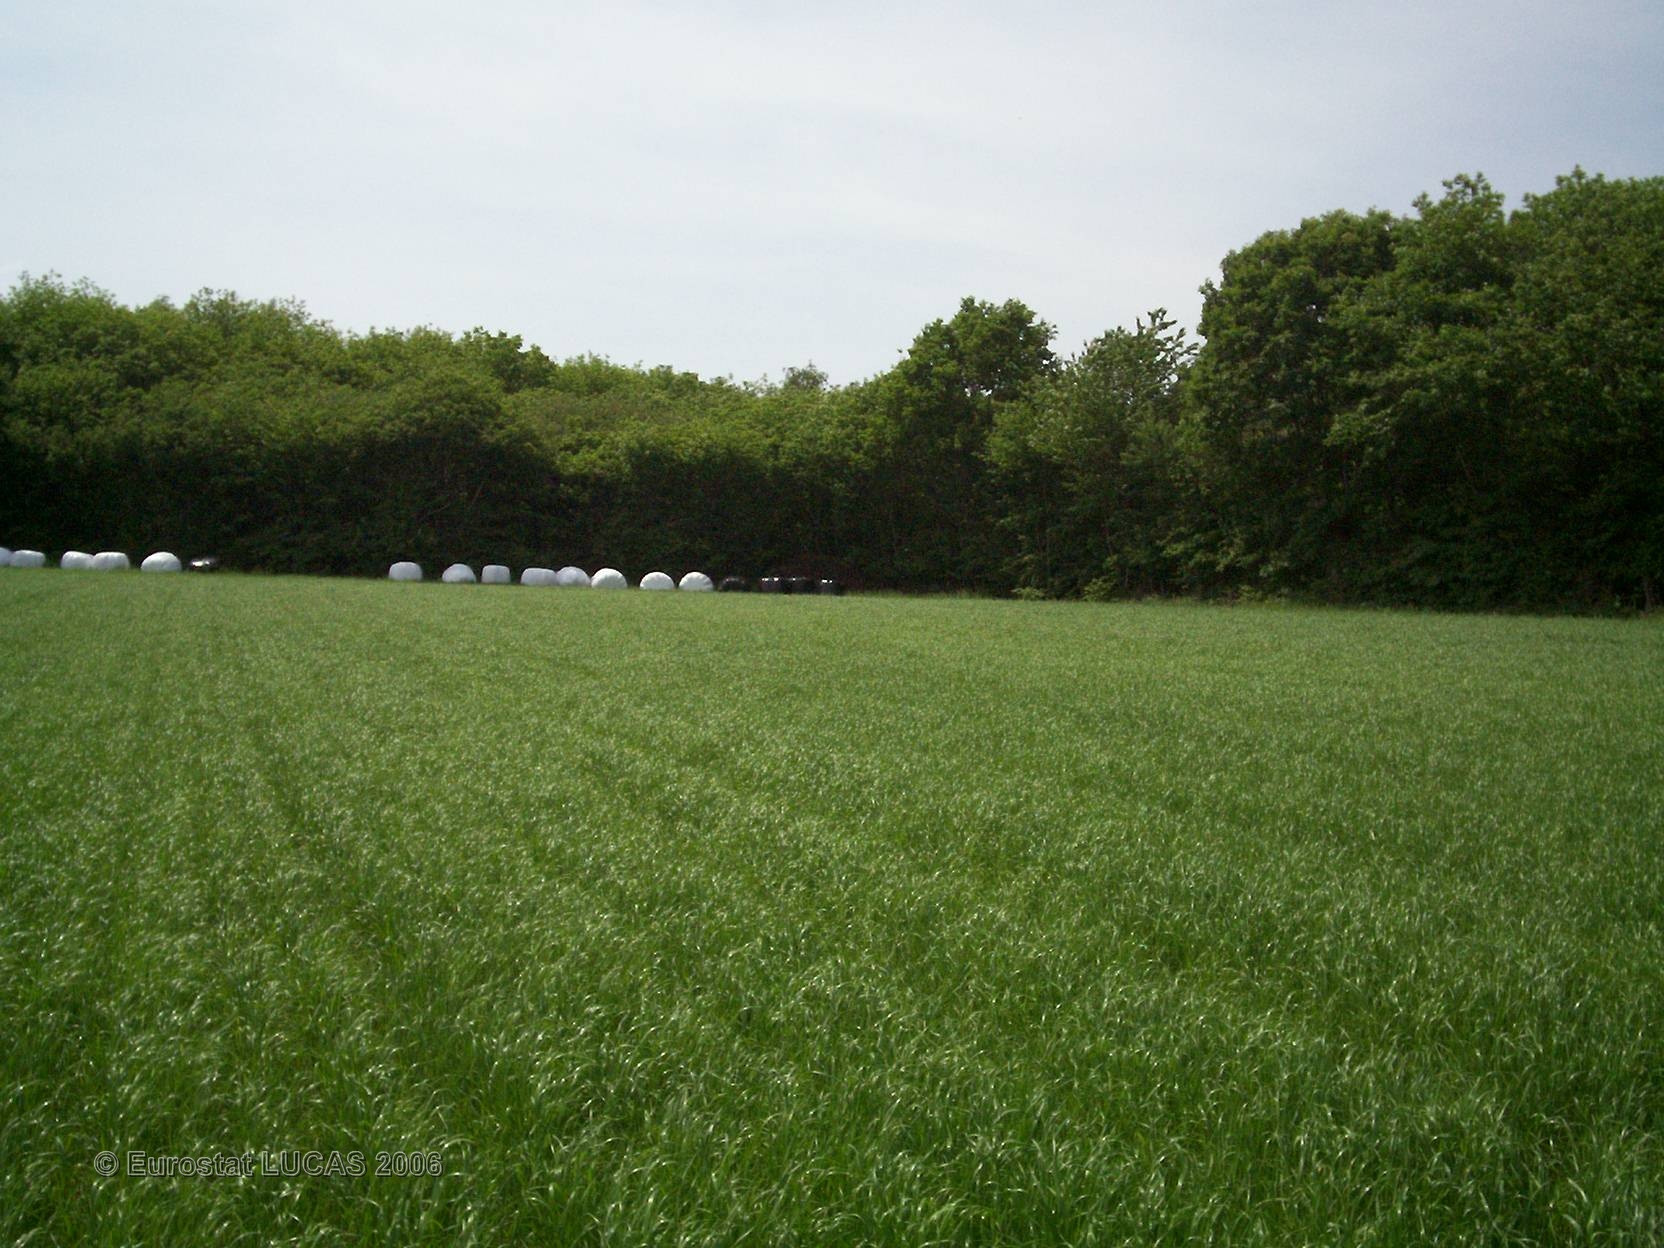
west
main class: Grassland
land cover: Grassland without tree/shrub cover
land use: Agriculture (excluding fallow land and kitchen gardens)
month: May
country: FR
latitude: 46.4876
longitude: -0.3030
